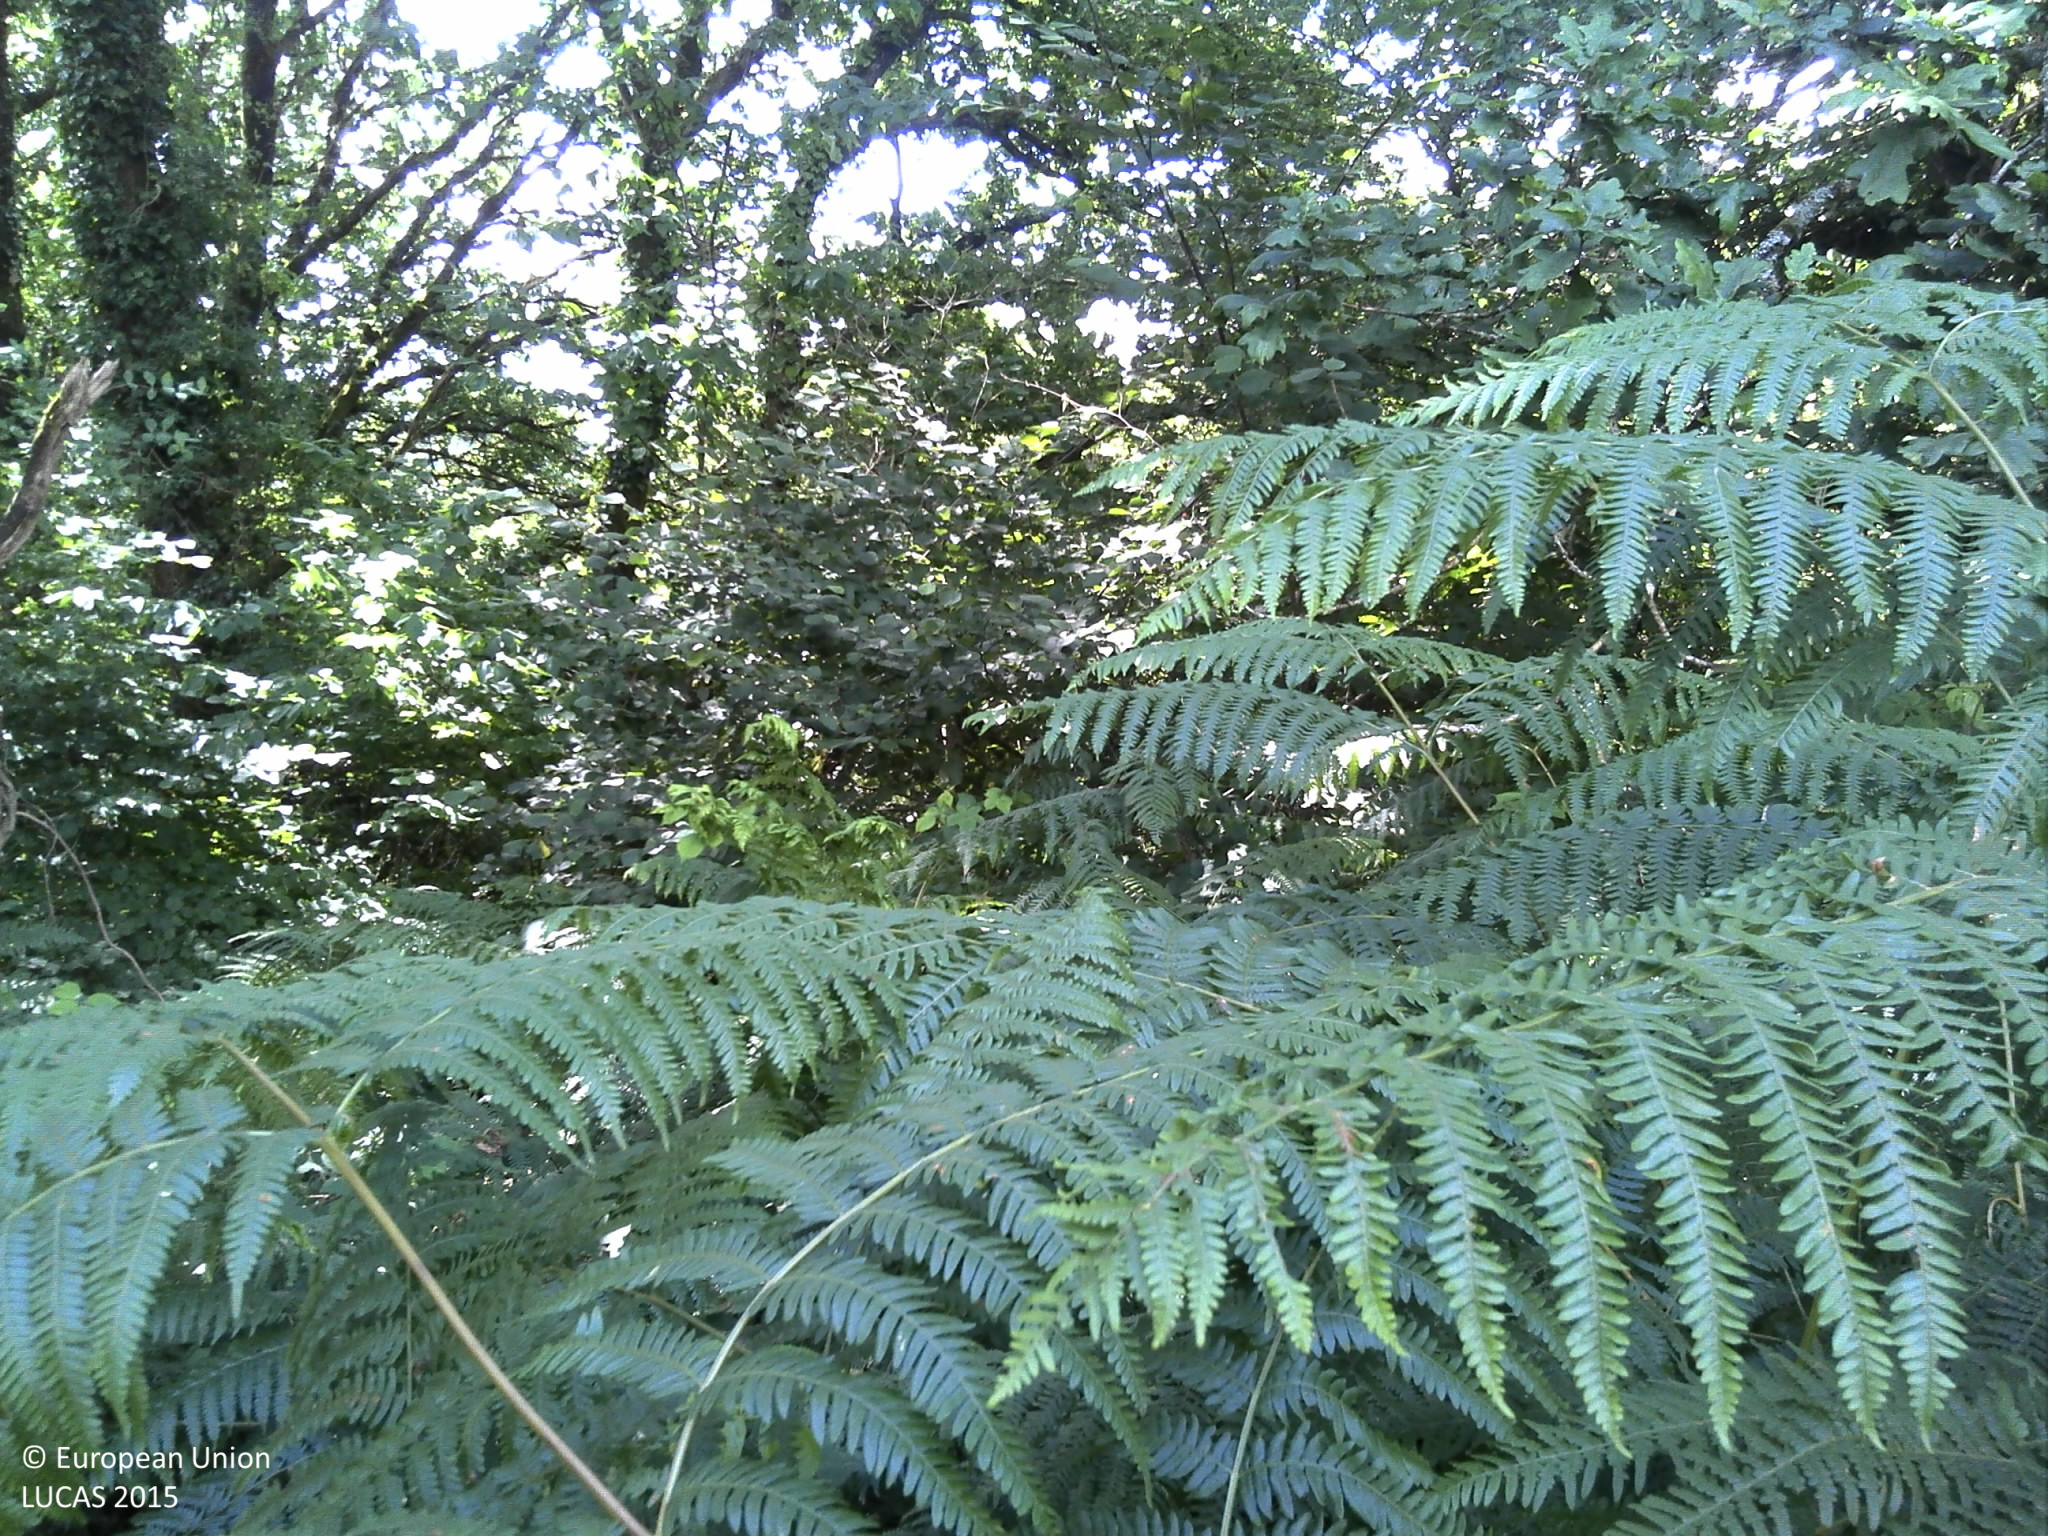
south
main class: Woodland
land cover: Broadleaved woodland
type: acidophilous oak and oak-birch forest
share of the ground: > 75 %
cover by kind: broadleaved forest trees 90 %, shrubs 5 %, herbaceous plants 5 %
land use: Semi-natural and natural areas not in use
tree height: > 5 m
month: July
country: FR
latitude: 48.3137
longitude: -3.6874
